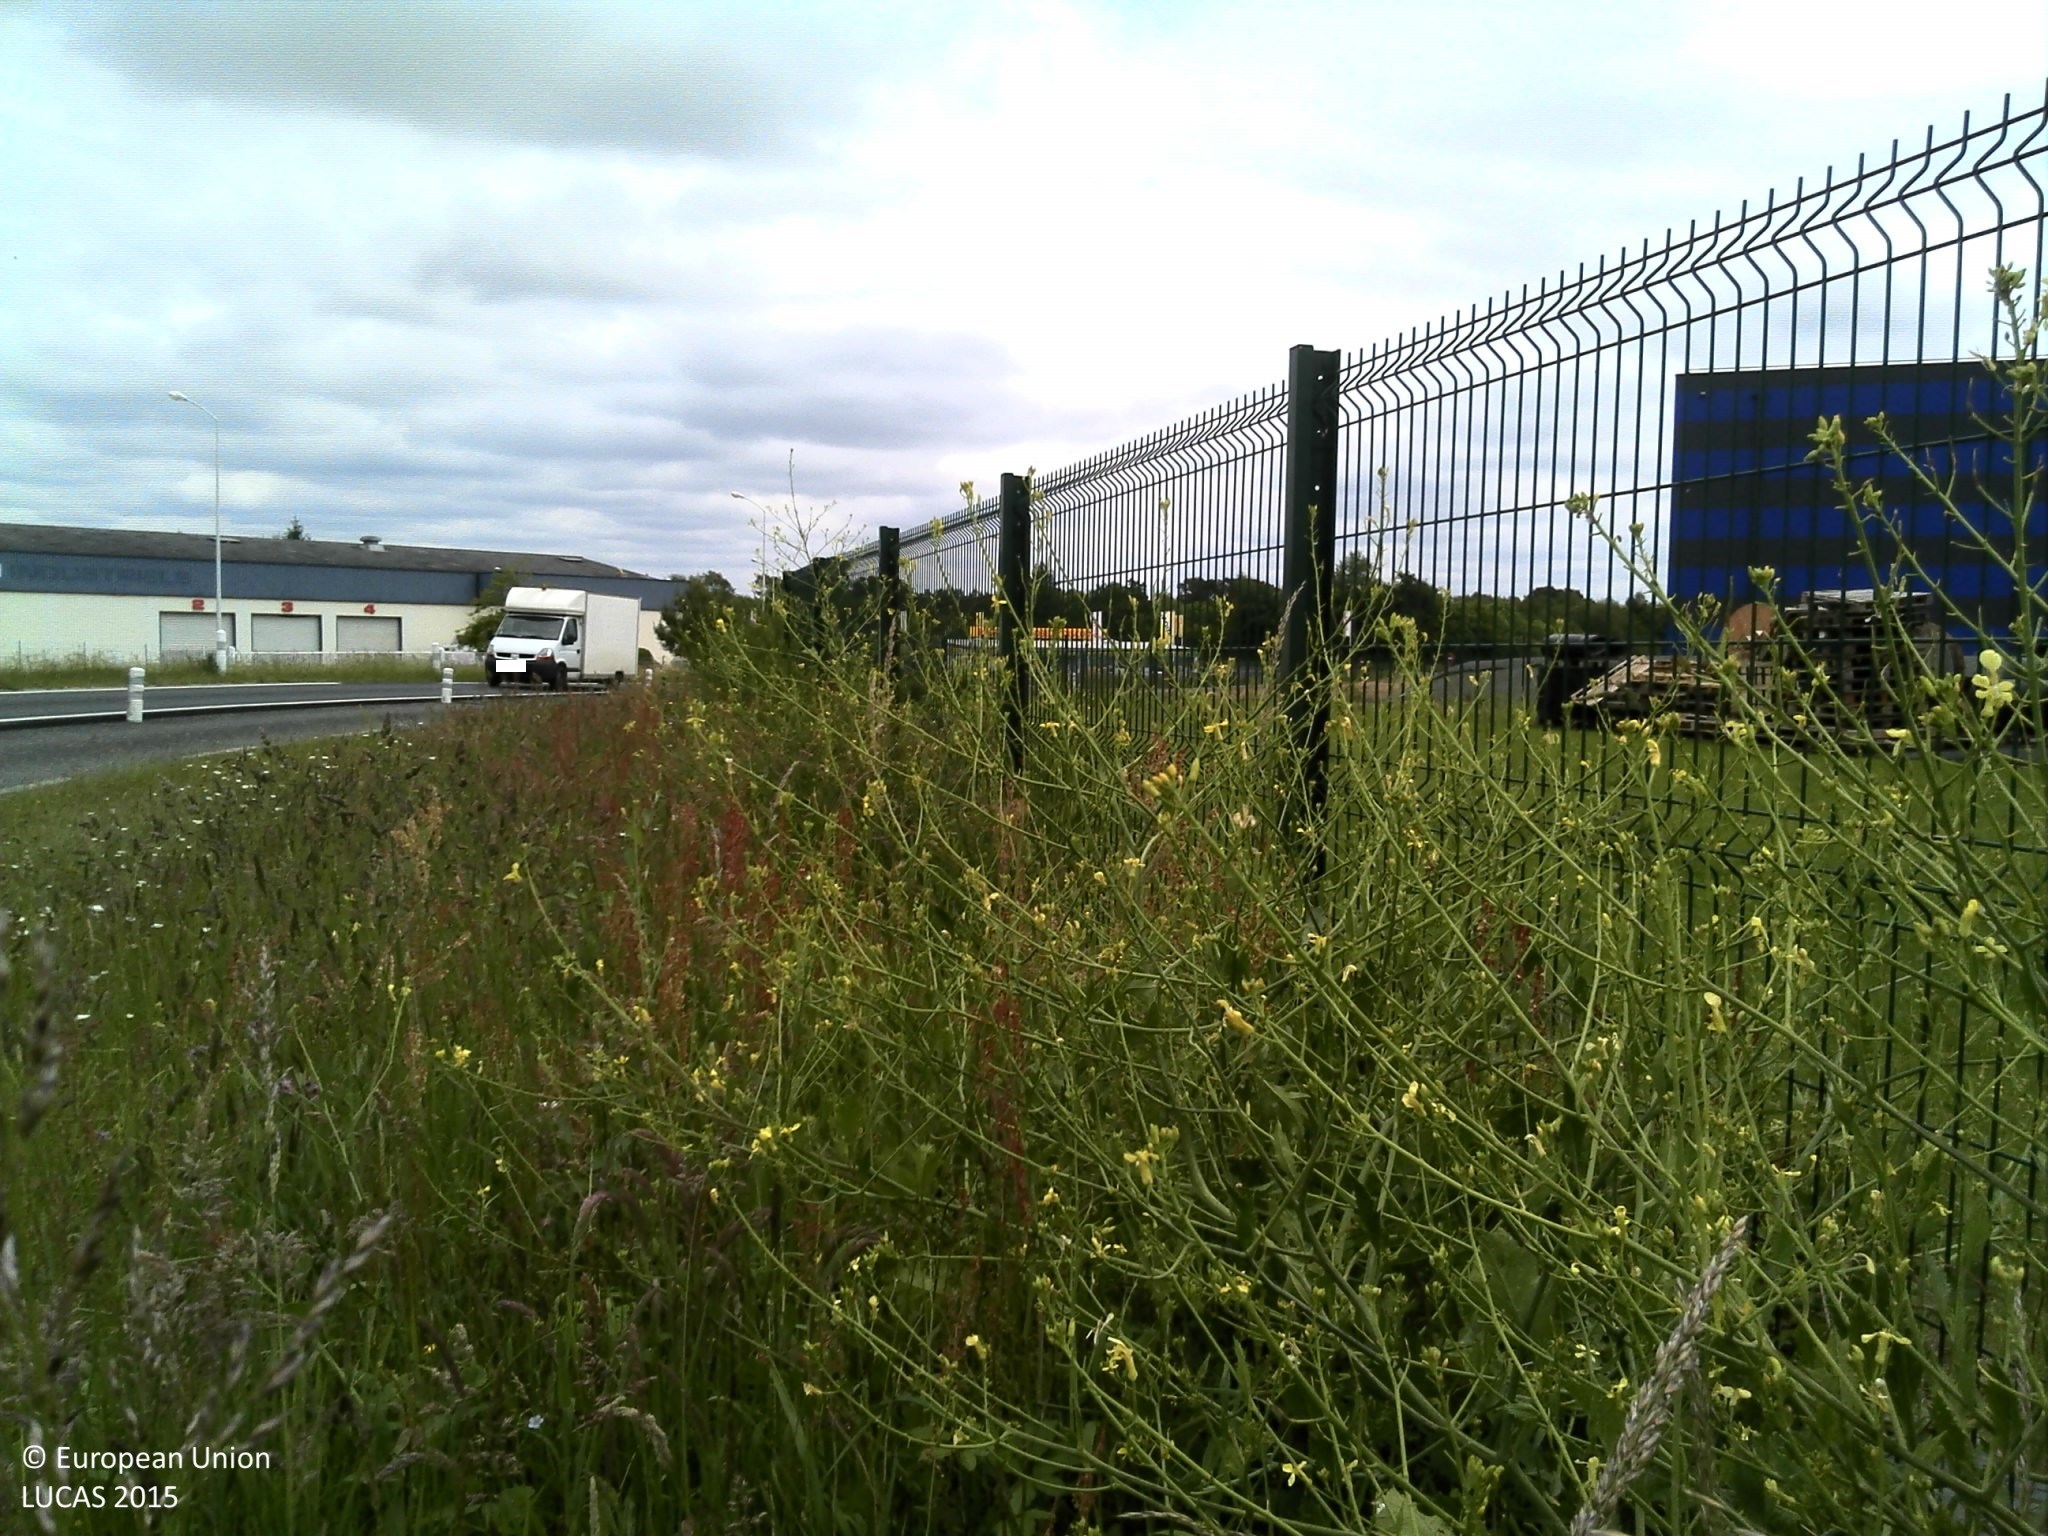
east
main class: Grassland
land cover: Grassland without tree/shrub cover
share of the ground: > 75 %
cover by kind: herbaceous plants 100 %
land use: Amenities, museums, leisure
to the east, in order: Grassland without tree/shrub cover; Artificial constructions in urban areas; Ditches and canals; Managed hedges; Grass margins; Tracks
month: May
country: FR
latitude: 47.8438
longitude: -3.5051
